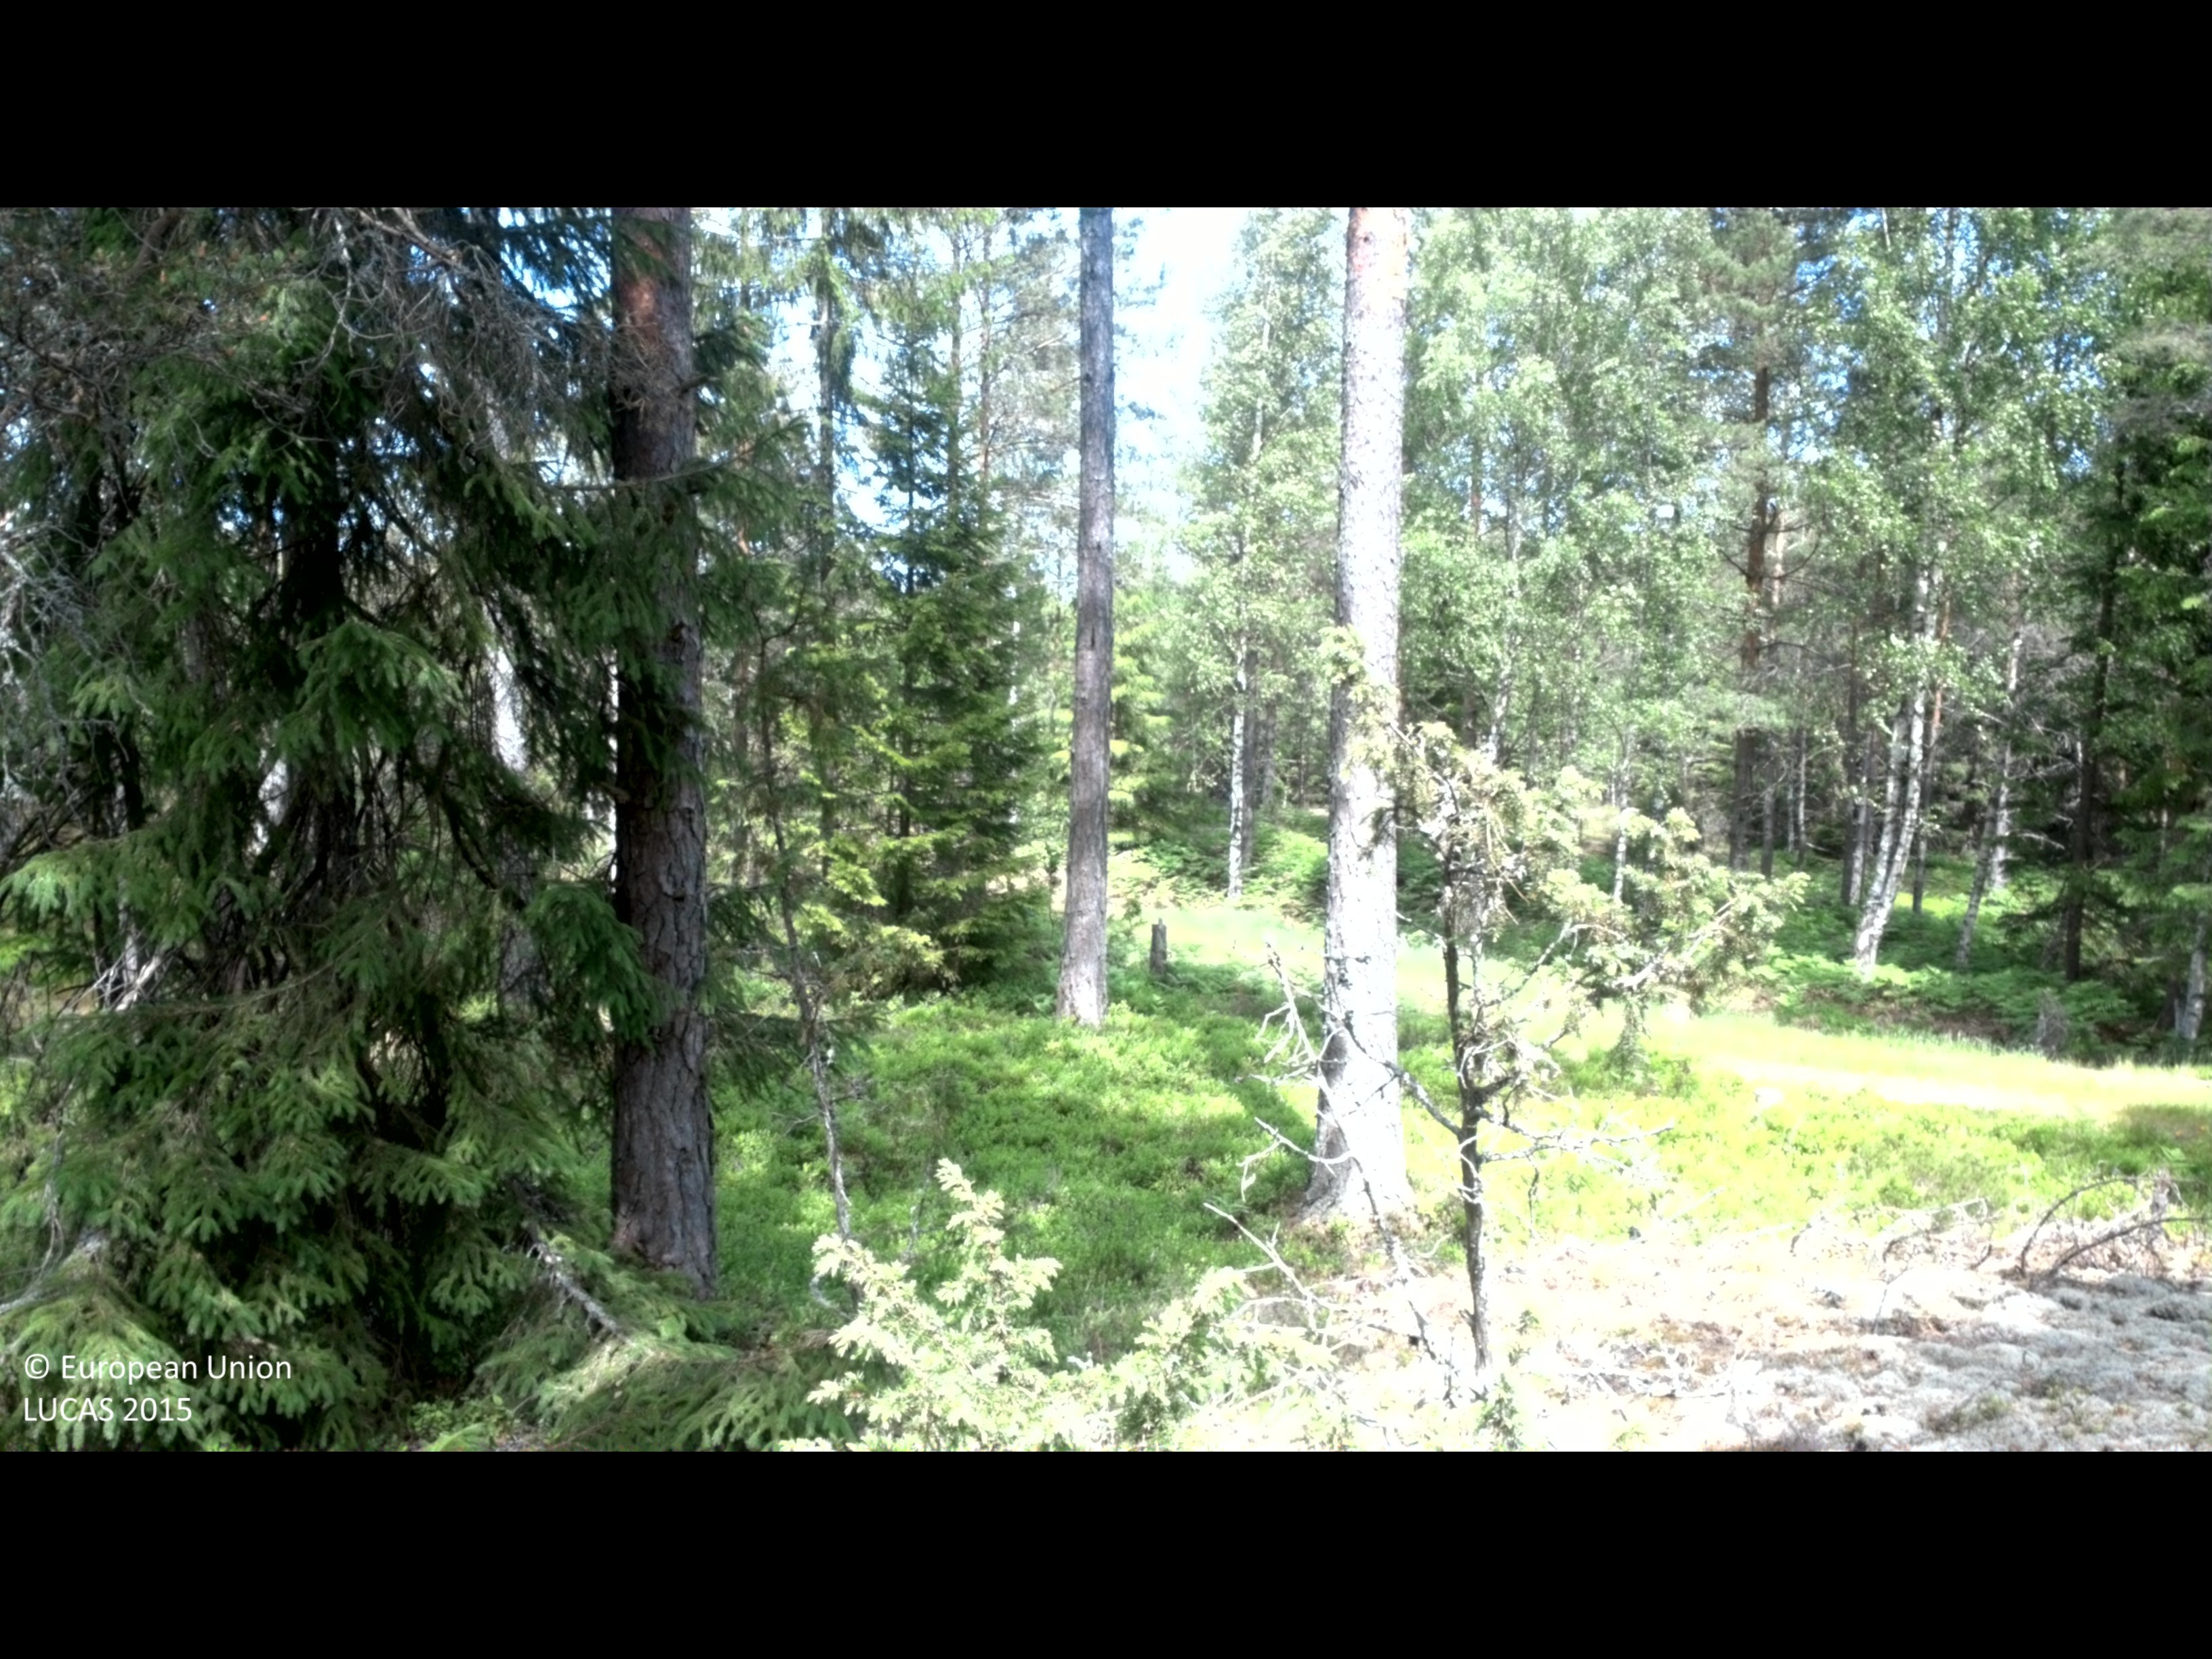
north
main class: Woodland
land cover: Other coniferous woodland
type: boreal forest
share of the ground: 50 - 75 %
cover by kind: coniferous forest trees 50 %, shrubs 30 %, lichens and mosses 15 %, broadleaved forest trees 5 %
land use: Forestry
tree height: > 5 m
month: June
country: SE
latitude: 57.6268
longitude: 16.5464
